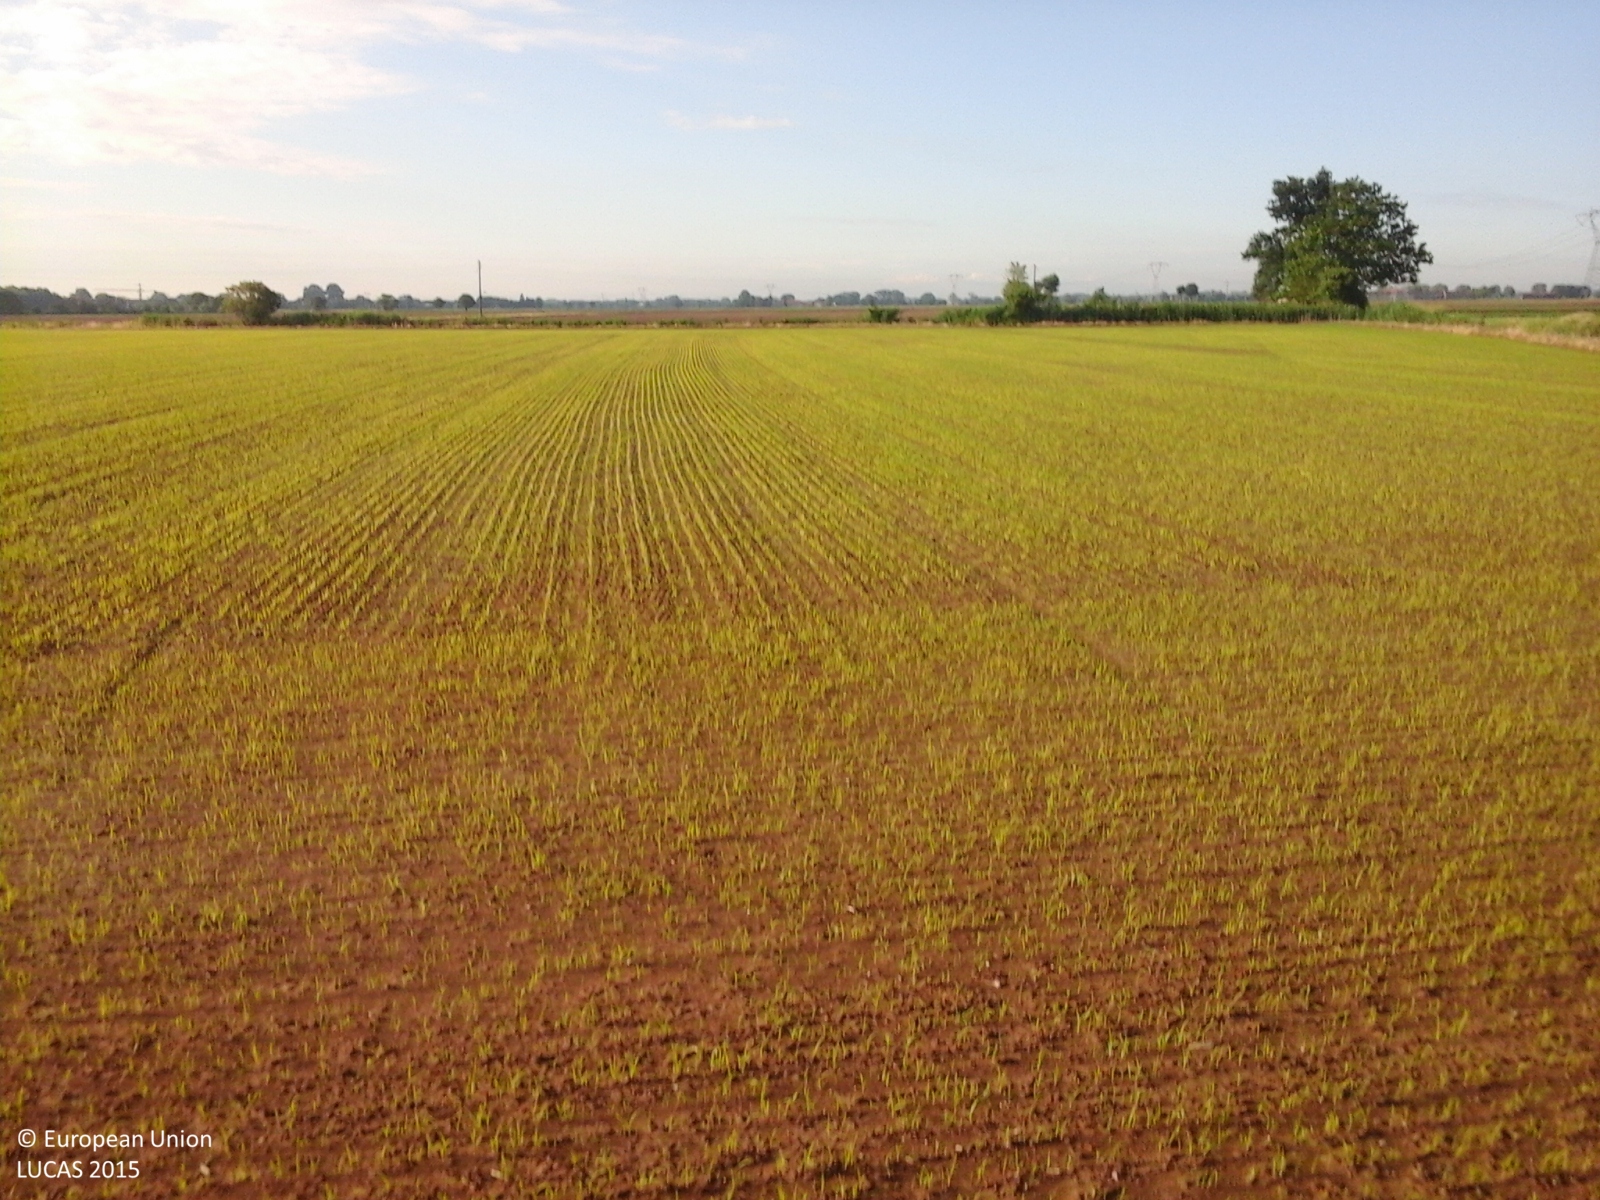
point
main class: Cropland
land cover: Rice
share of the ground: 10 - 25 %
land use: Agriculture (excluding fallow land and kitchen gardens)
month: May
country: IT
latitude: 45.3744
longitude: 9.0950
